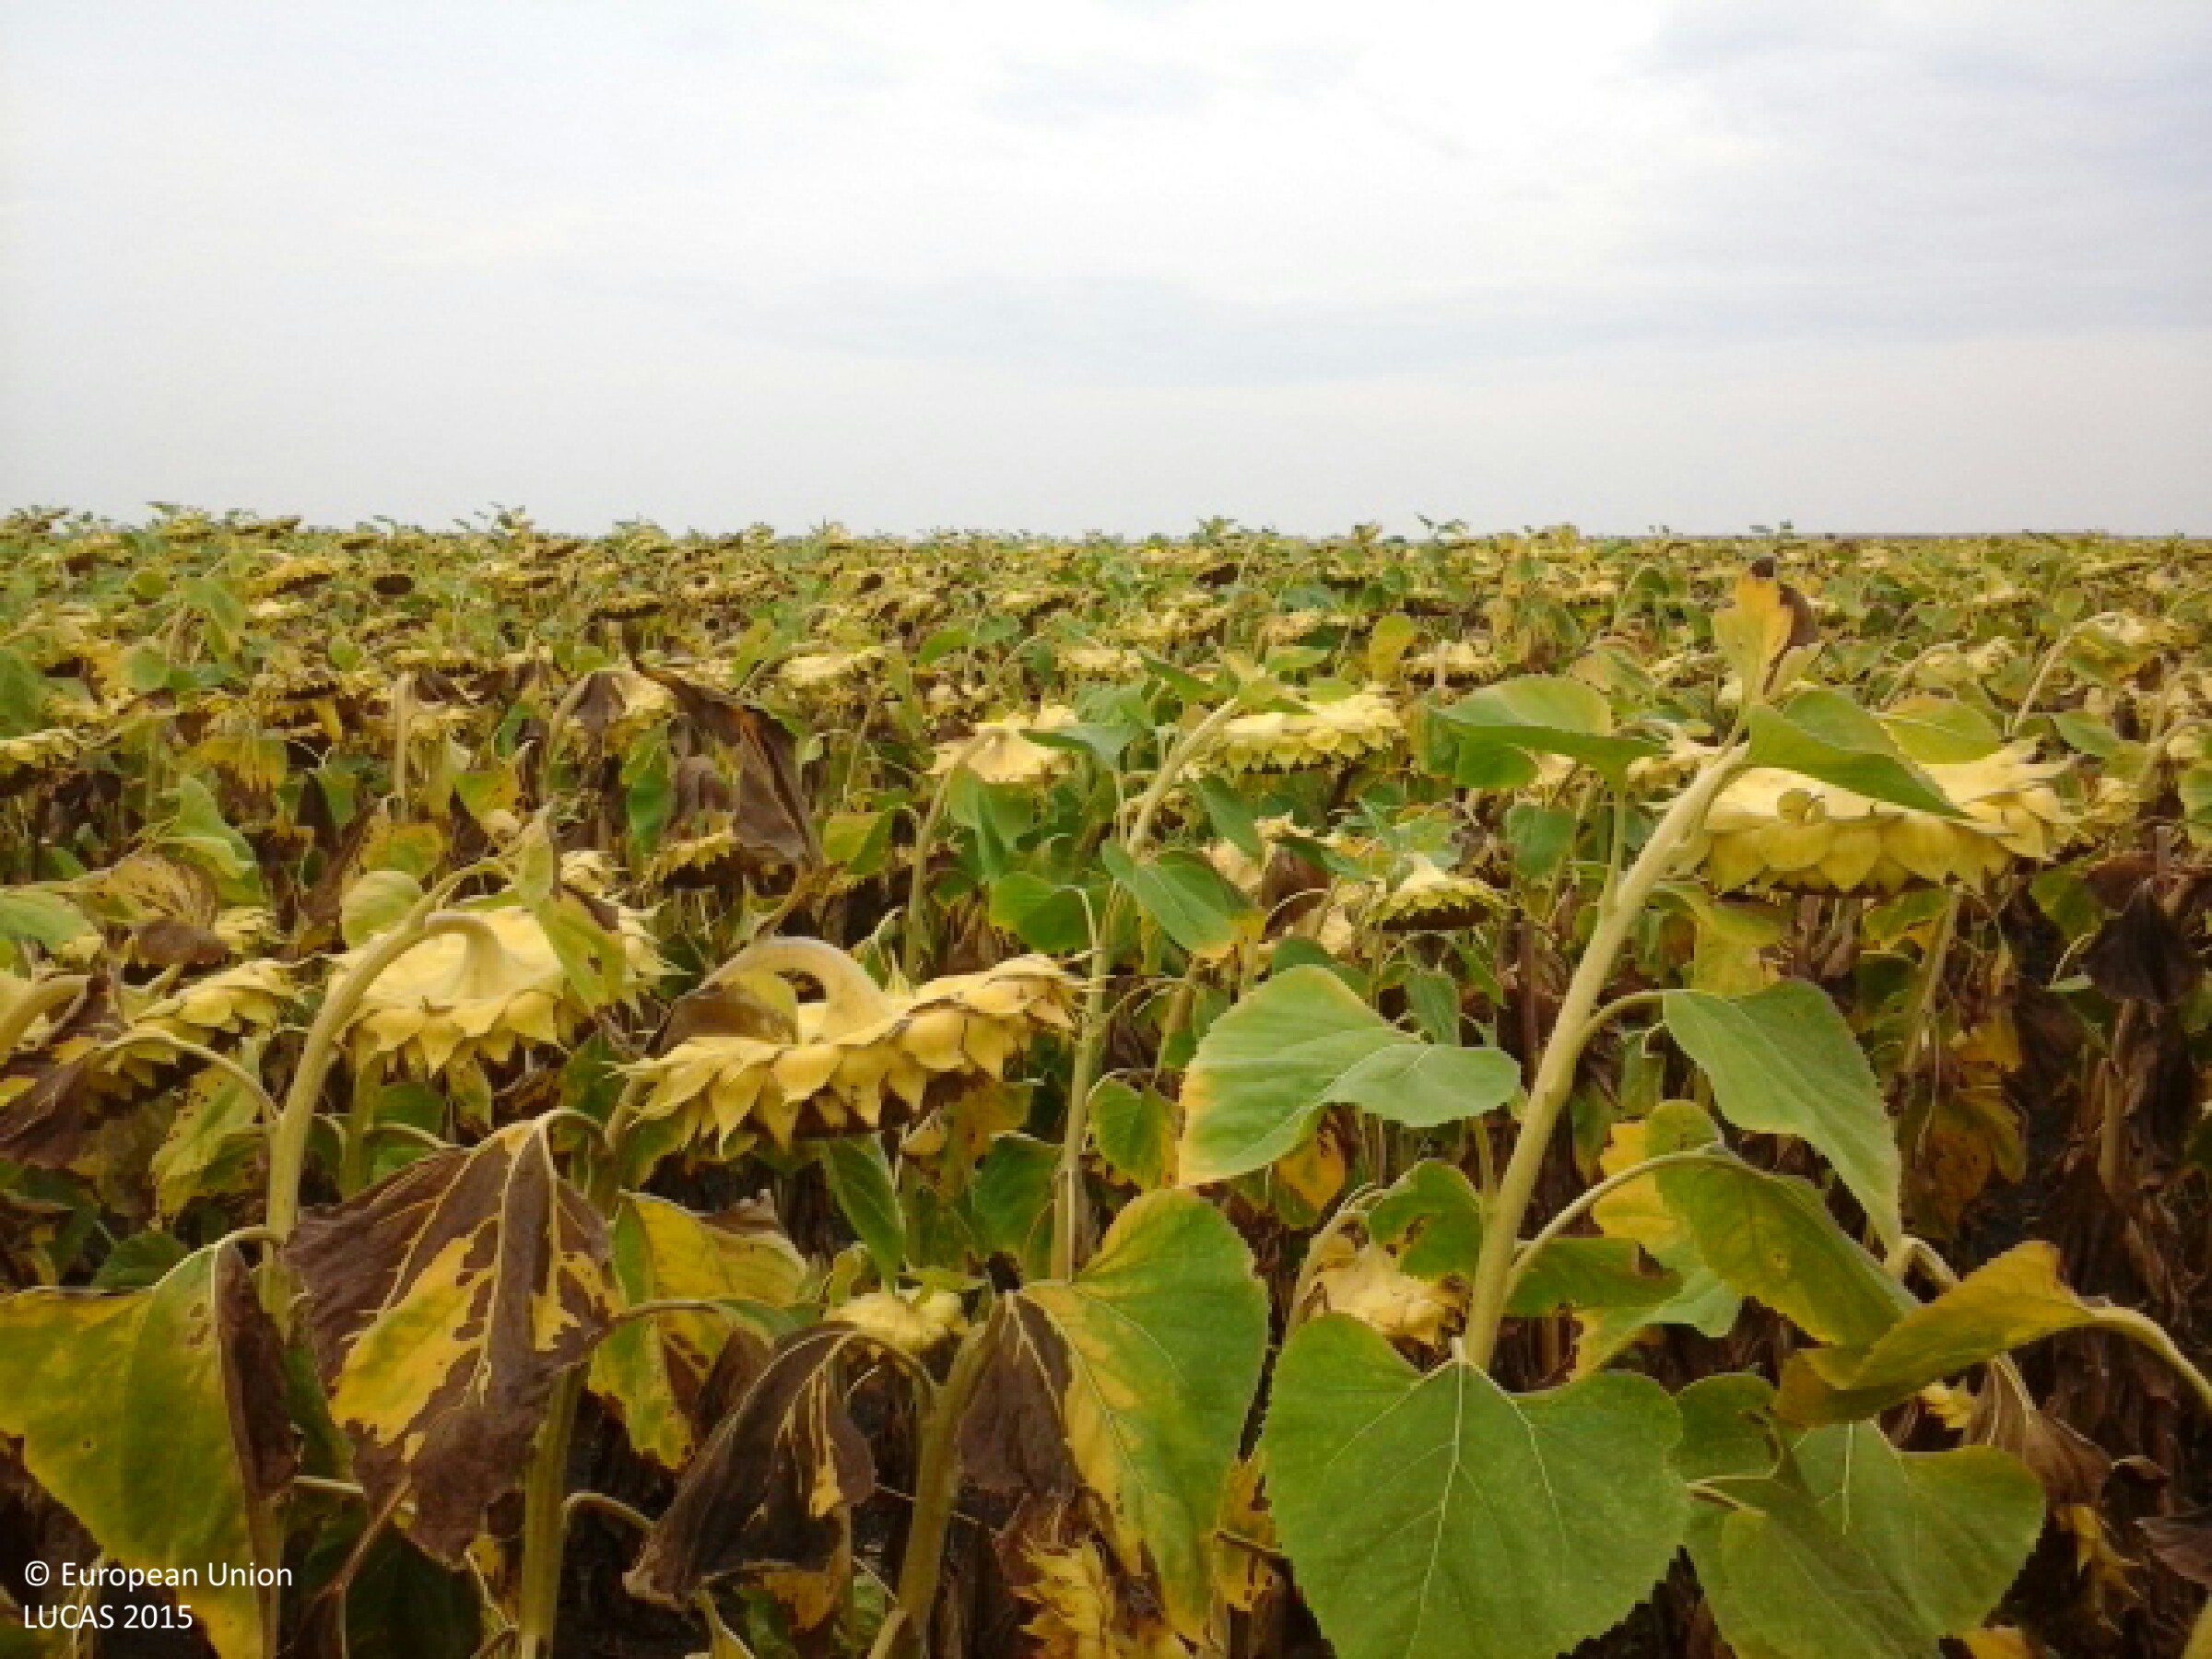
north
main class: Cropland
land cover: Sunflower
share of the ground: > 75 %
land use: Agriculture (excluding fallow land and kitchen gardens)
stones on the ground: < 10 %
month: August
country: HU
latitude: 47.1896
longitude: 21.7778
